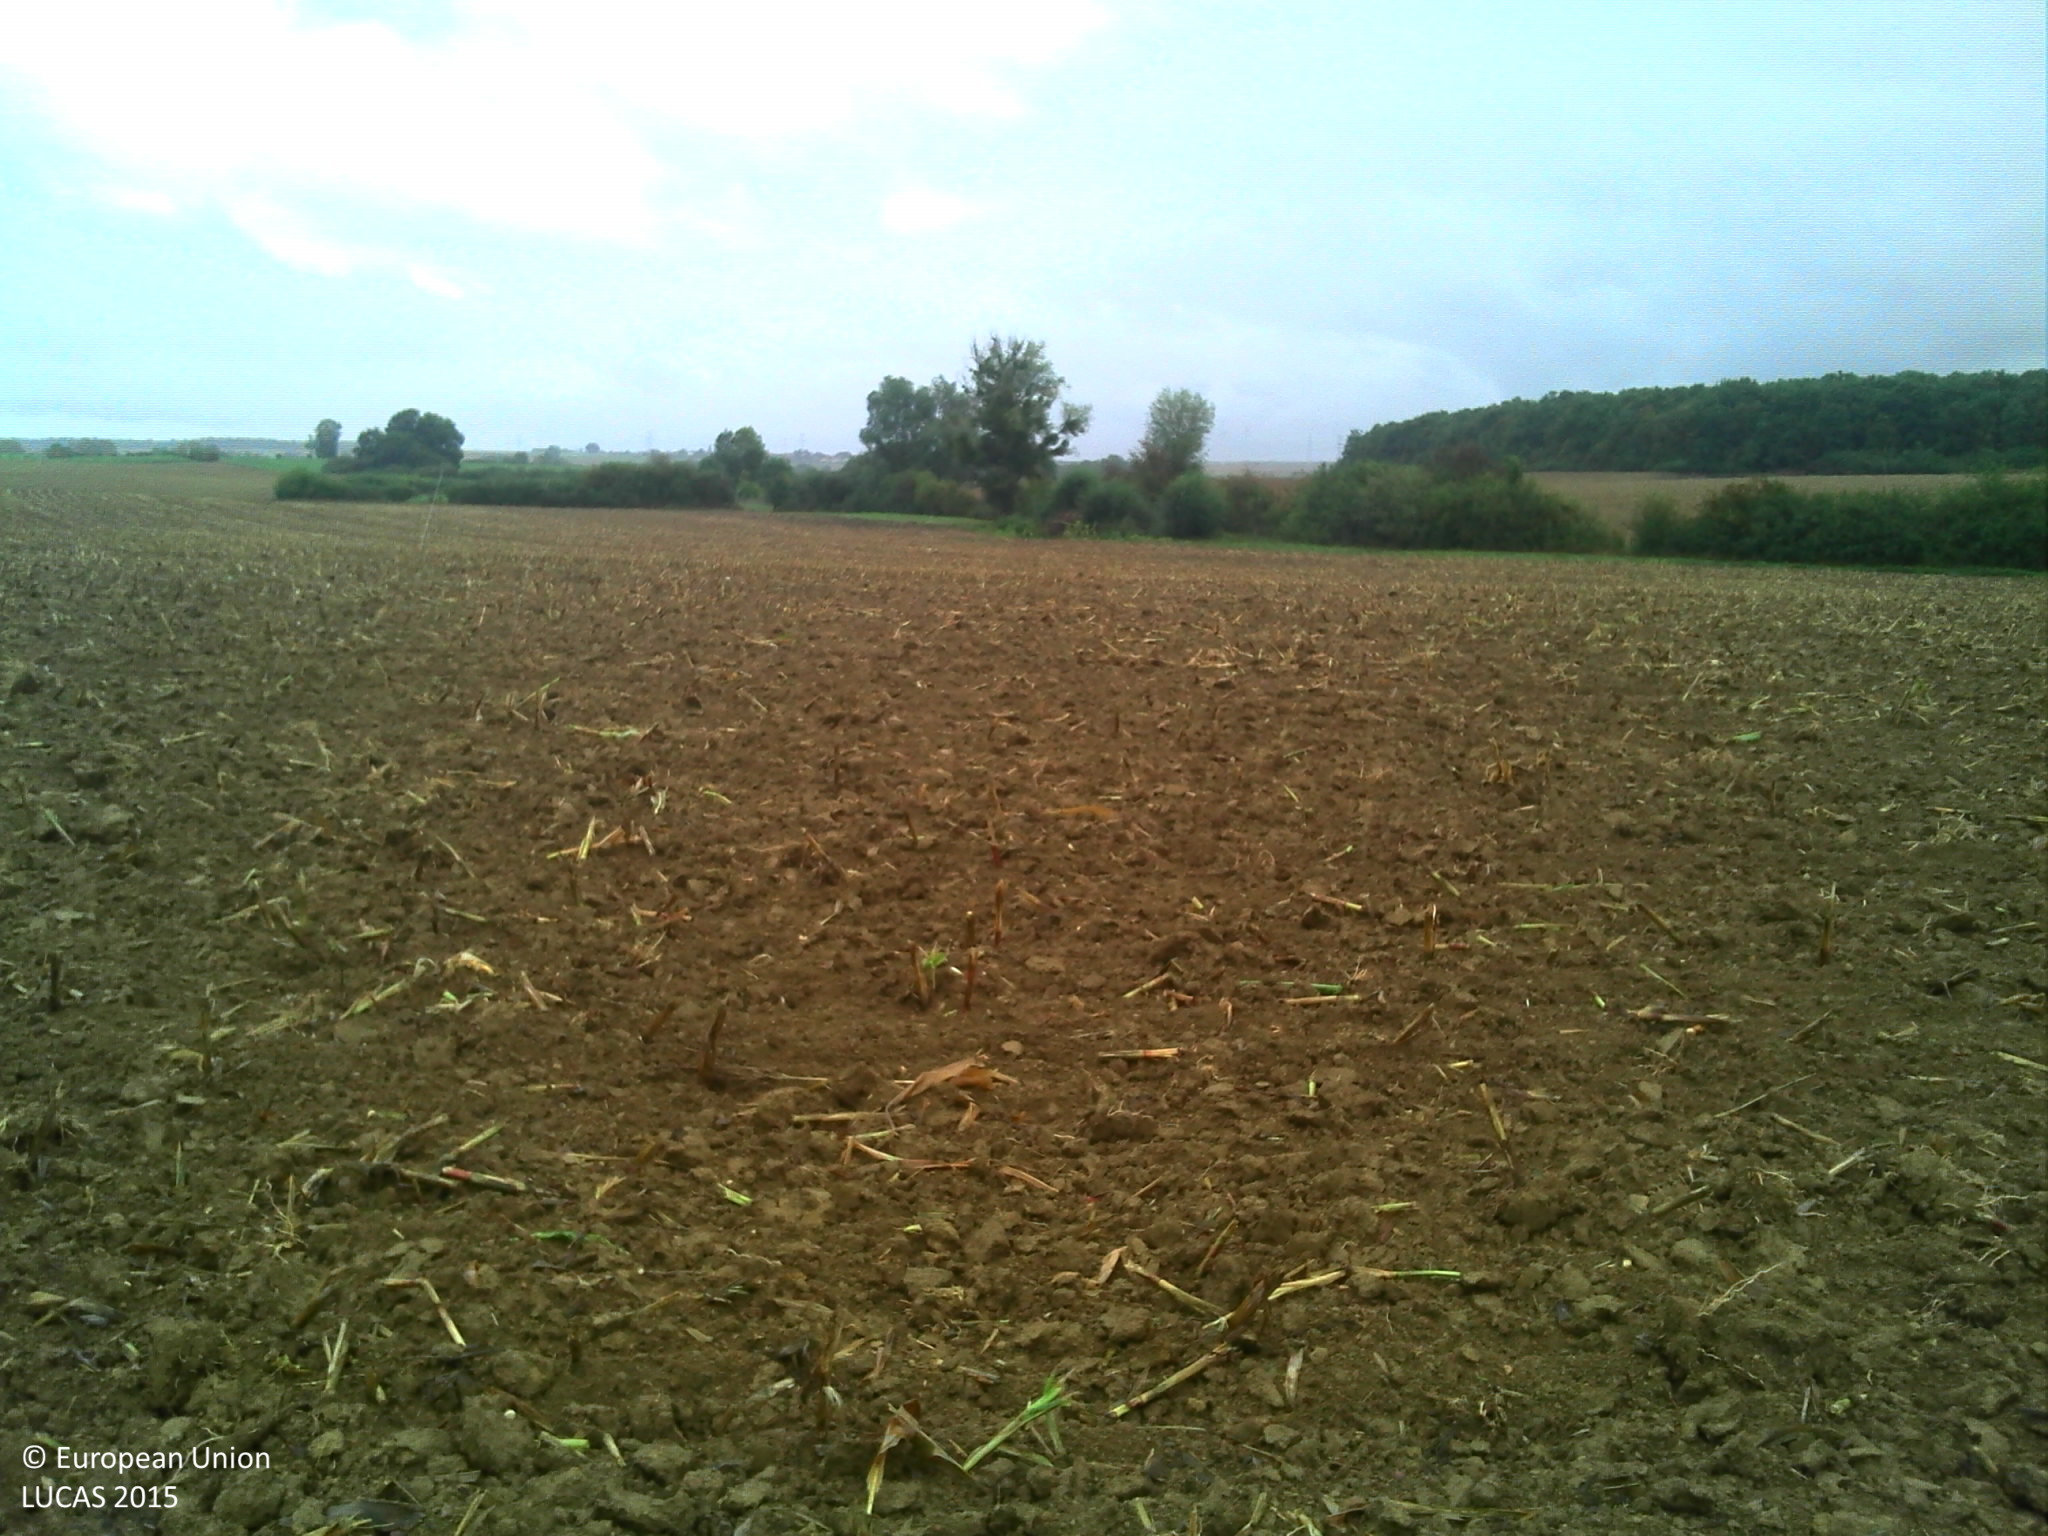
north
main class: Cropland
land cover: Maize
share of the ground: < 10 %
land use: Agriculture (excluding fallow land and kitchen gardens)
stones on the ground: < 10 %
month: September
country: FR
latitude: 49.2269
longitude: 5.8661
